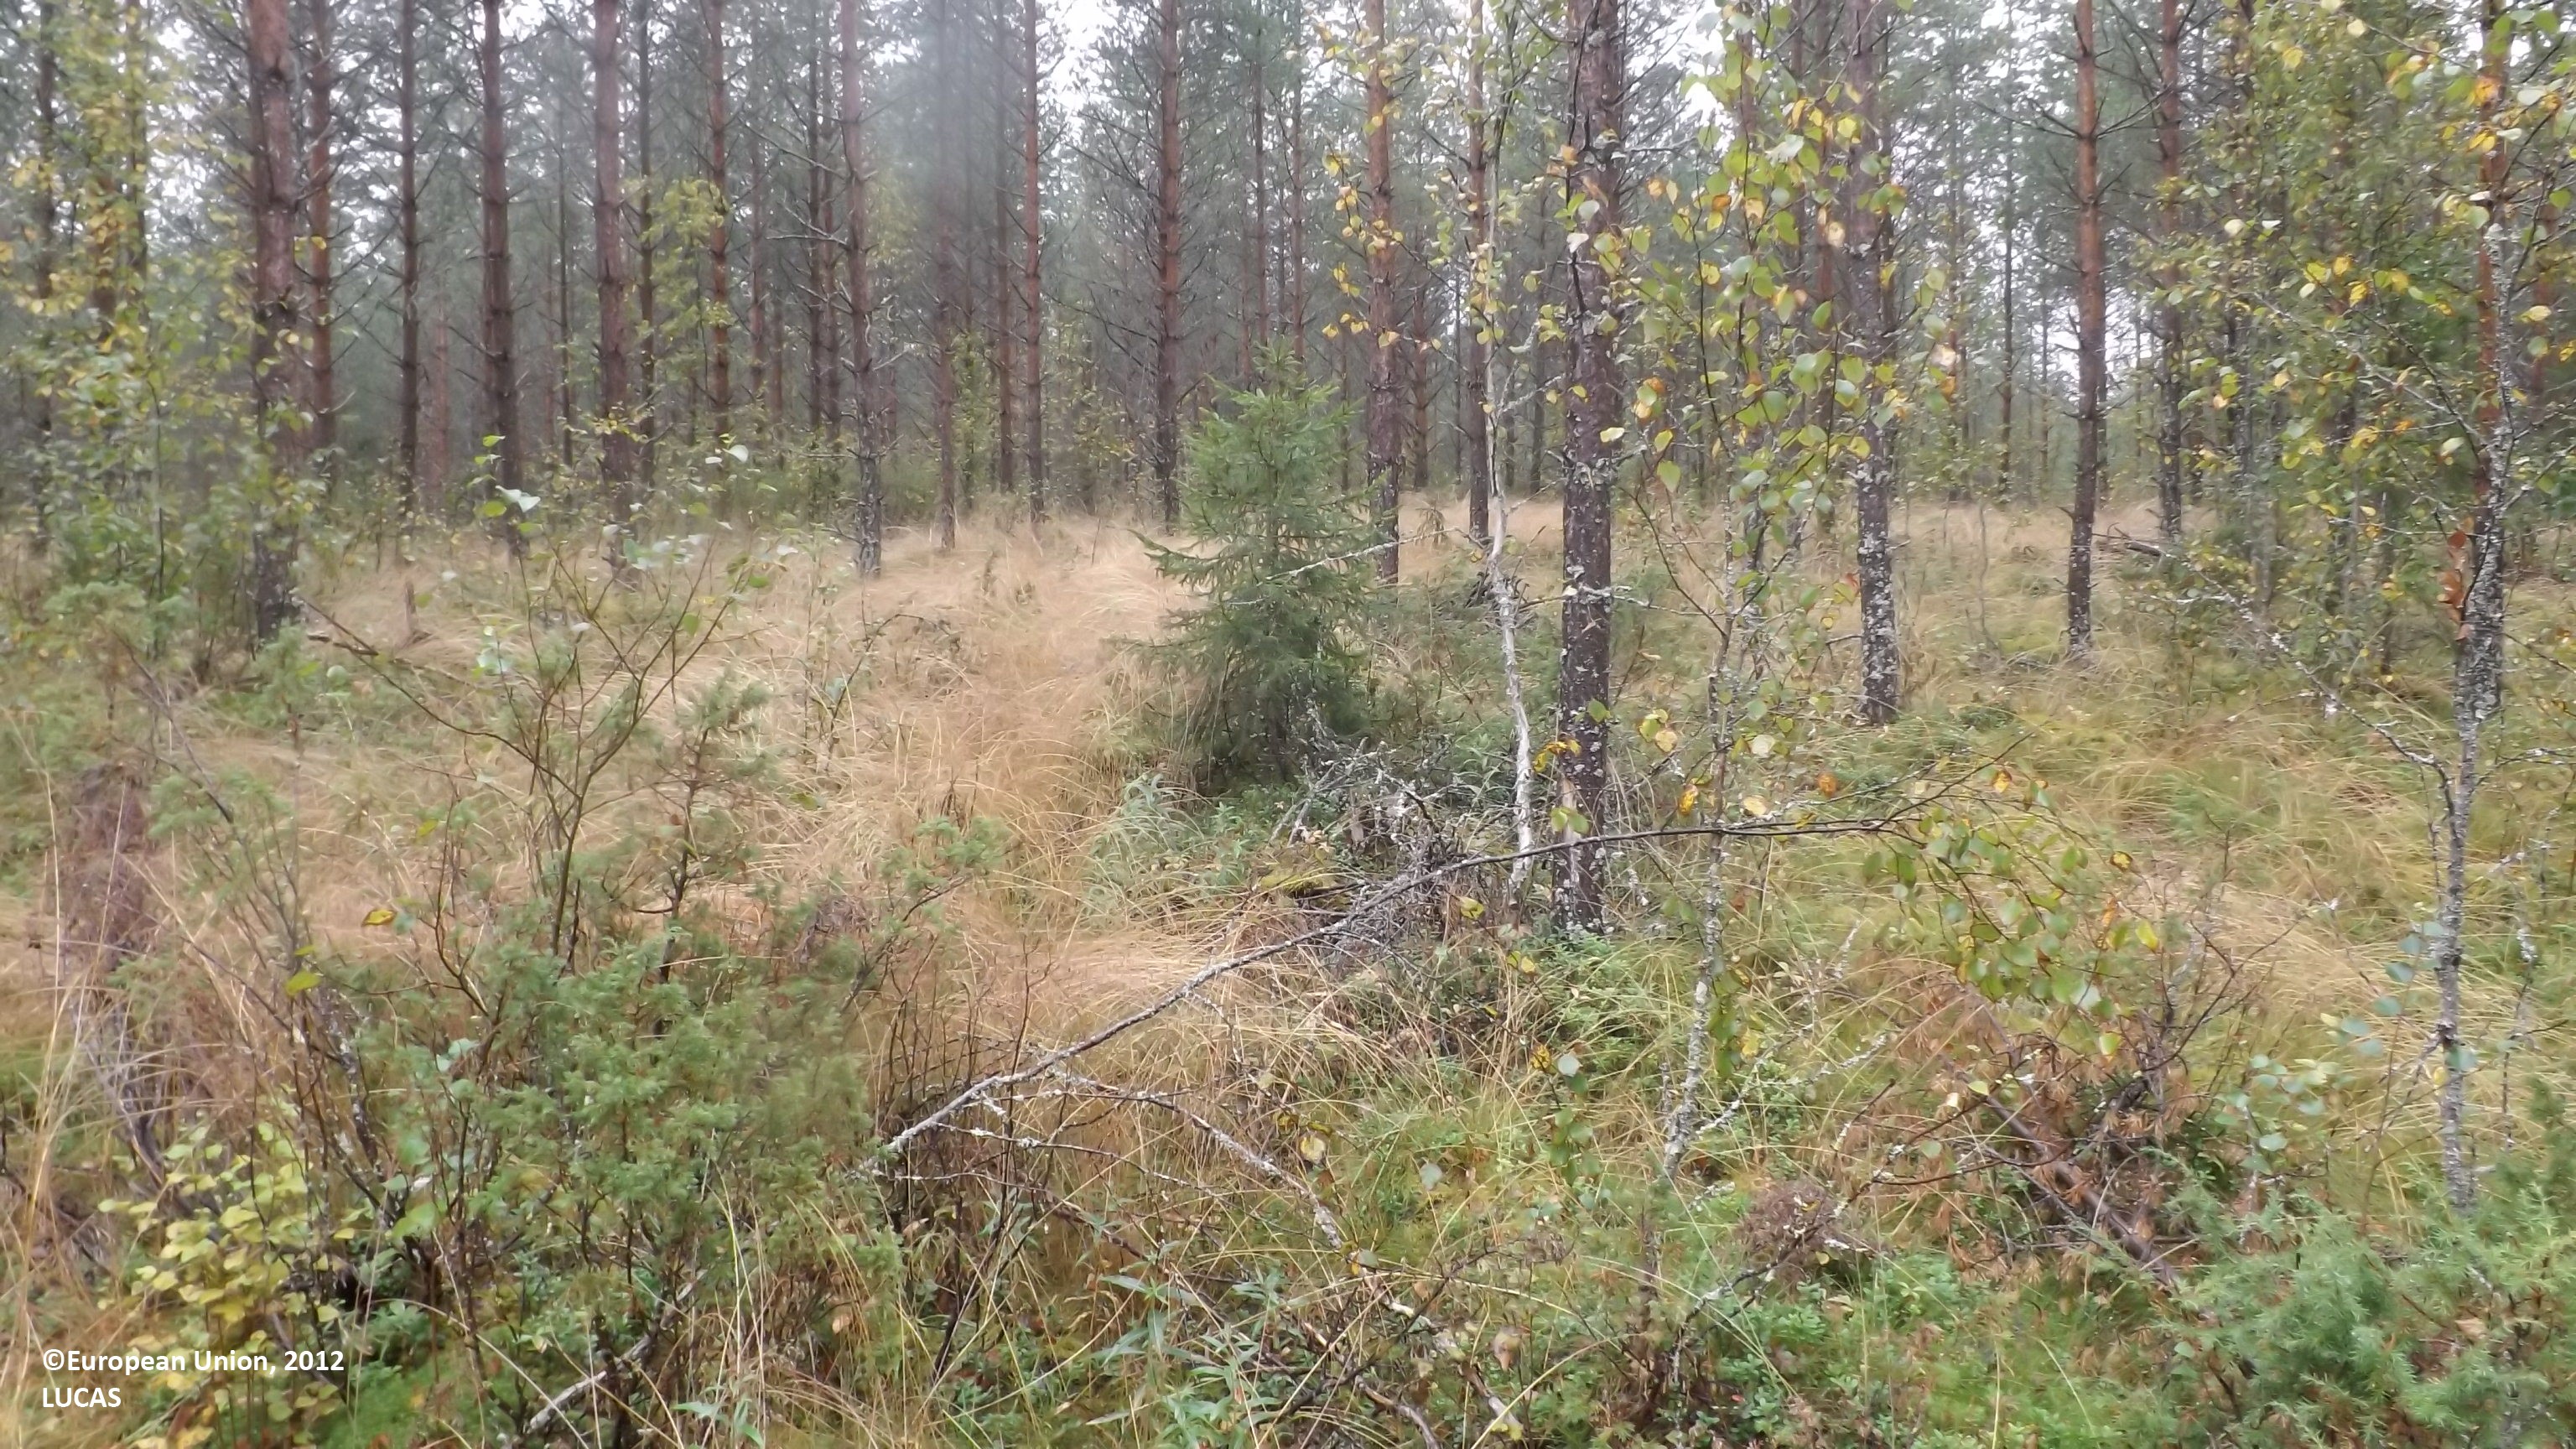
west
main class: Woodland
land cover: Pine dominated mixed woodland
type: boreal forest
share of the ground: 25 - 50 %
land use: Forestry
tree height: > 5 m
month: August
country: FI
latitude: 63.7912
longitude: 23.5971
